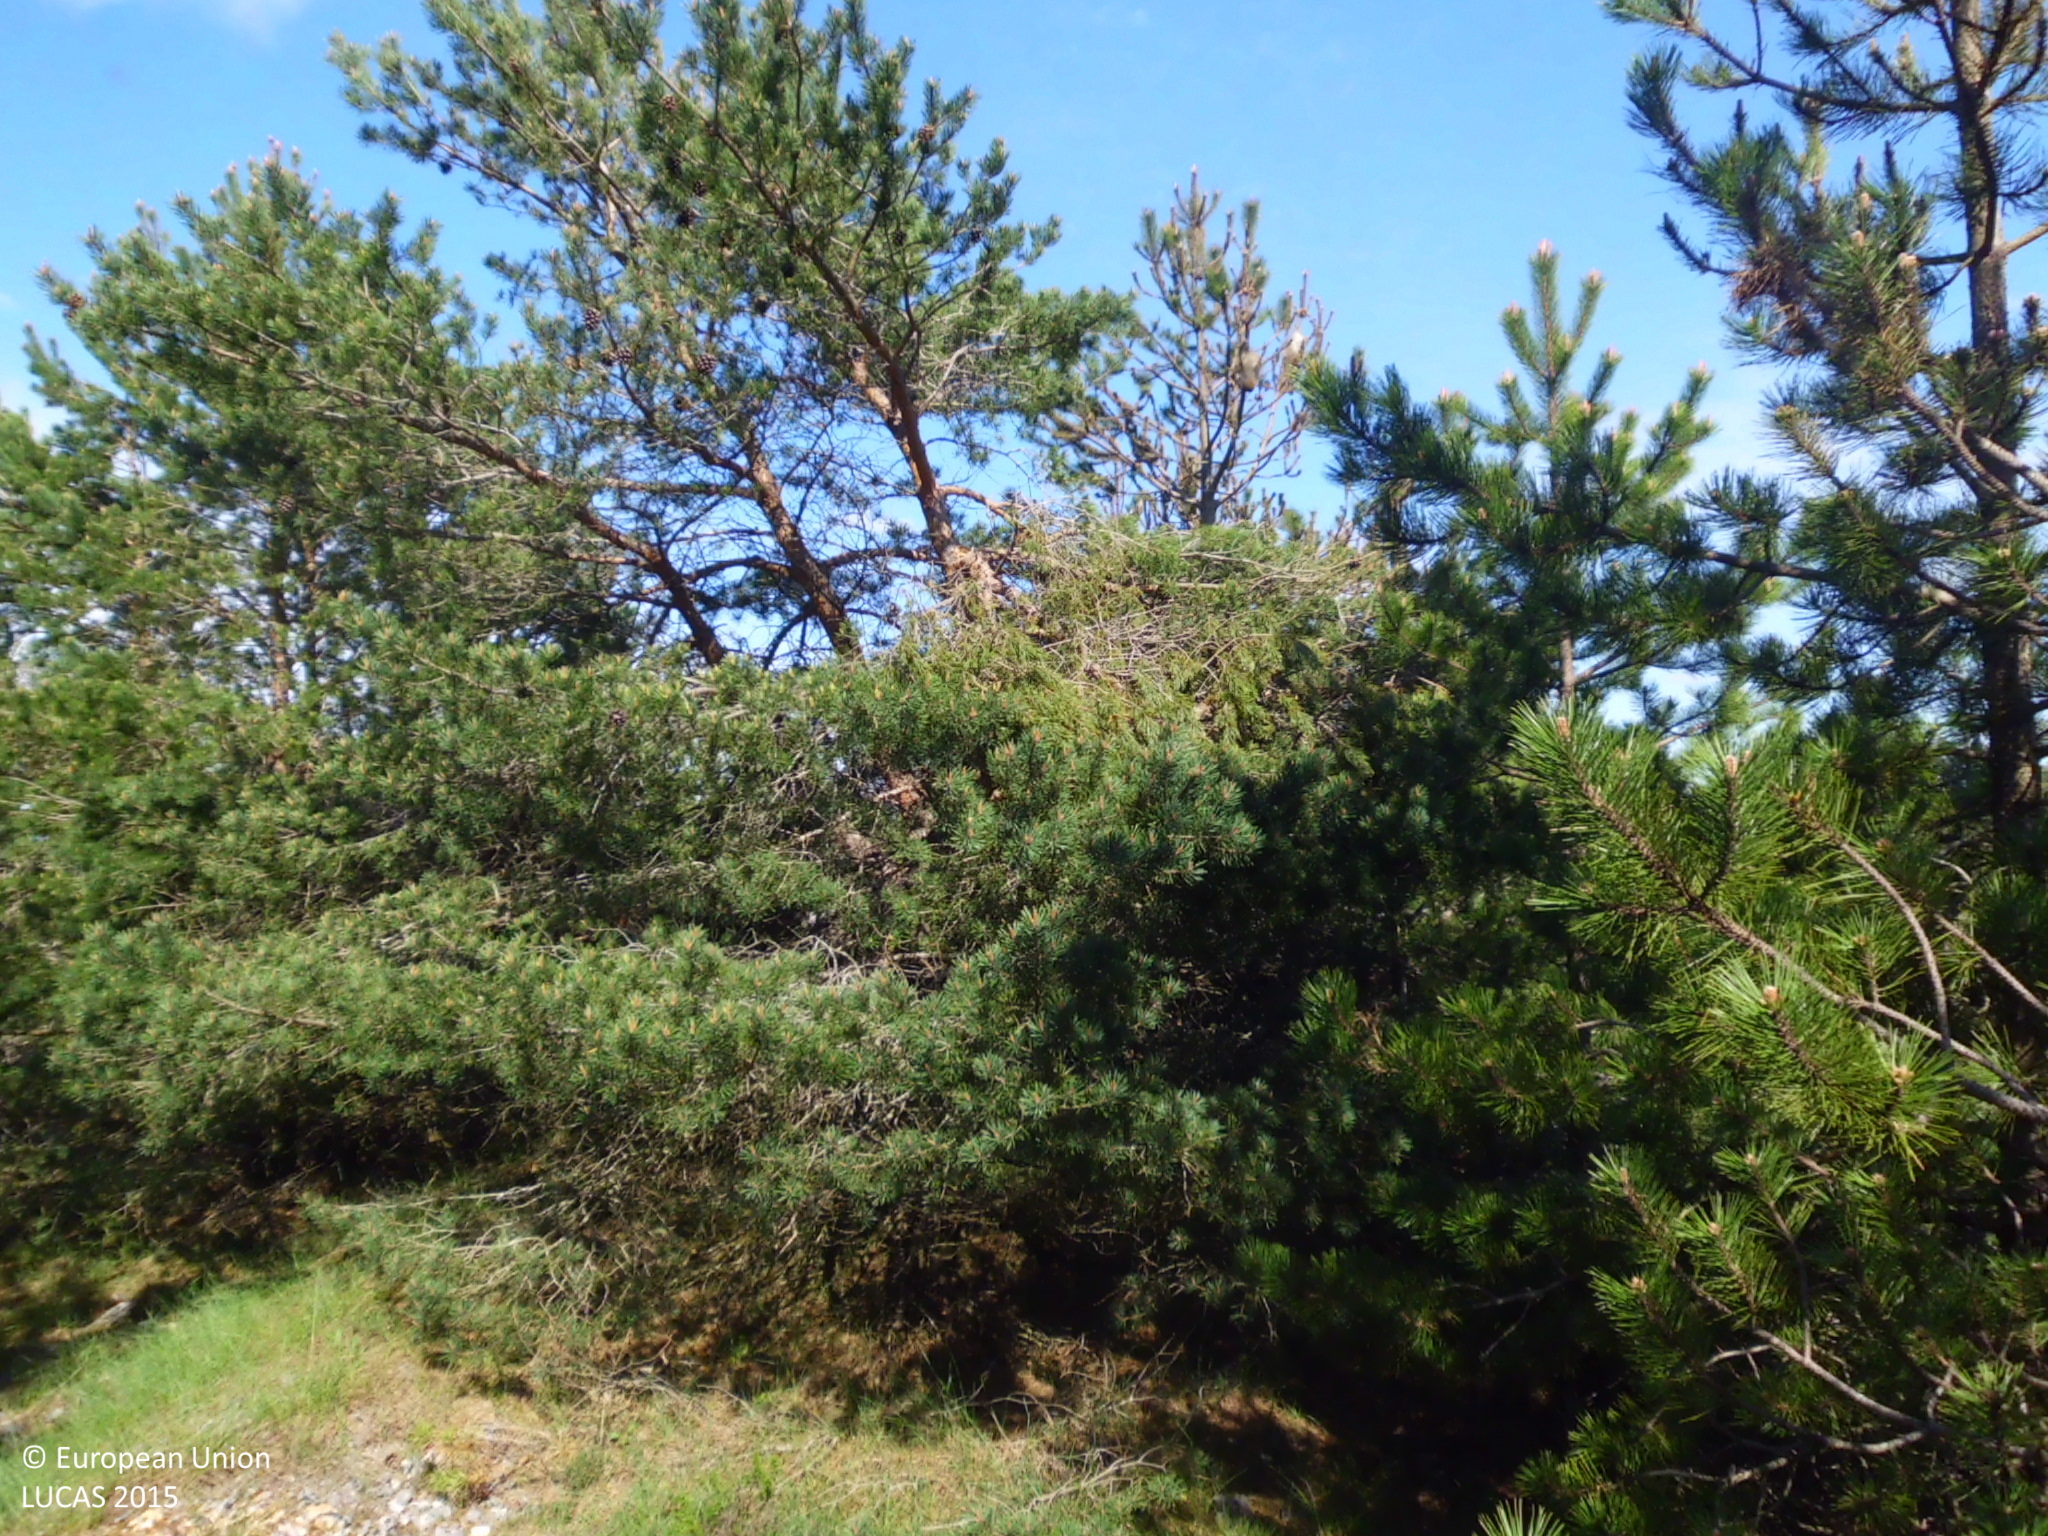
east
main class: Woodland
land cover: Pine dominated coniferous woodland
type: coniferous forest of the mediterranean region
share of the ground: > 75 %
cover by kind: coniferous forest trees 50 %, herbaceous plants 30 %, shrubs 15 %, consolidated bare surface 5 %
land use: Forestry
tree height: < 5 m
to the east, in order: Pine dominated coniferous woodland; Tracks; Shrubland with sparse tree cover
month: May
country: ES
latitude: 42.6681
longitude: -3.8415
